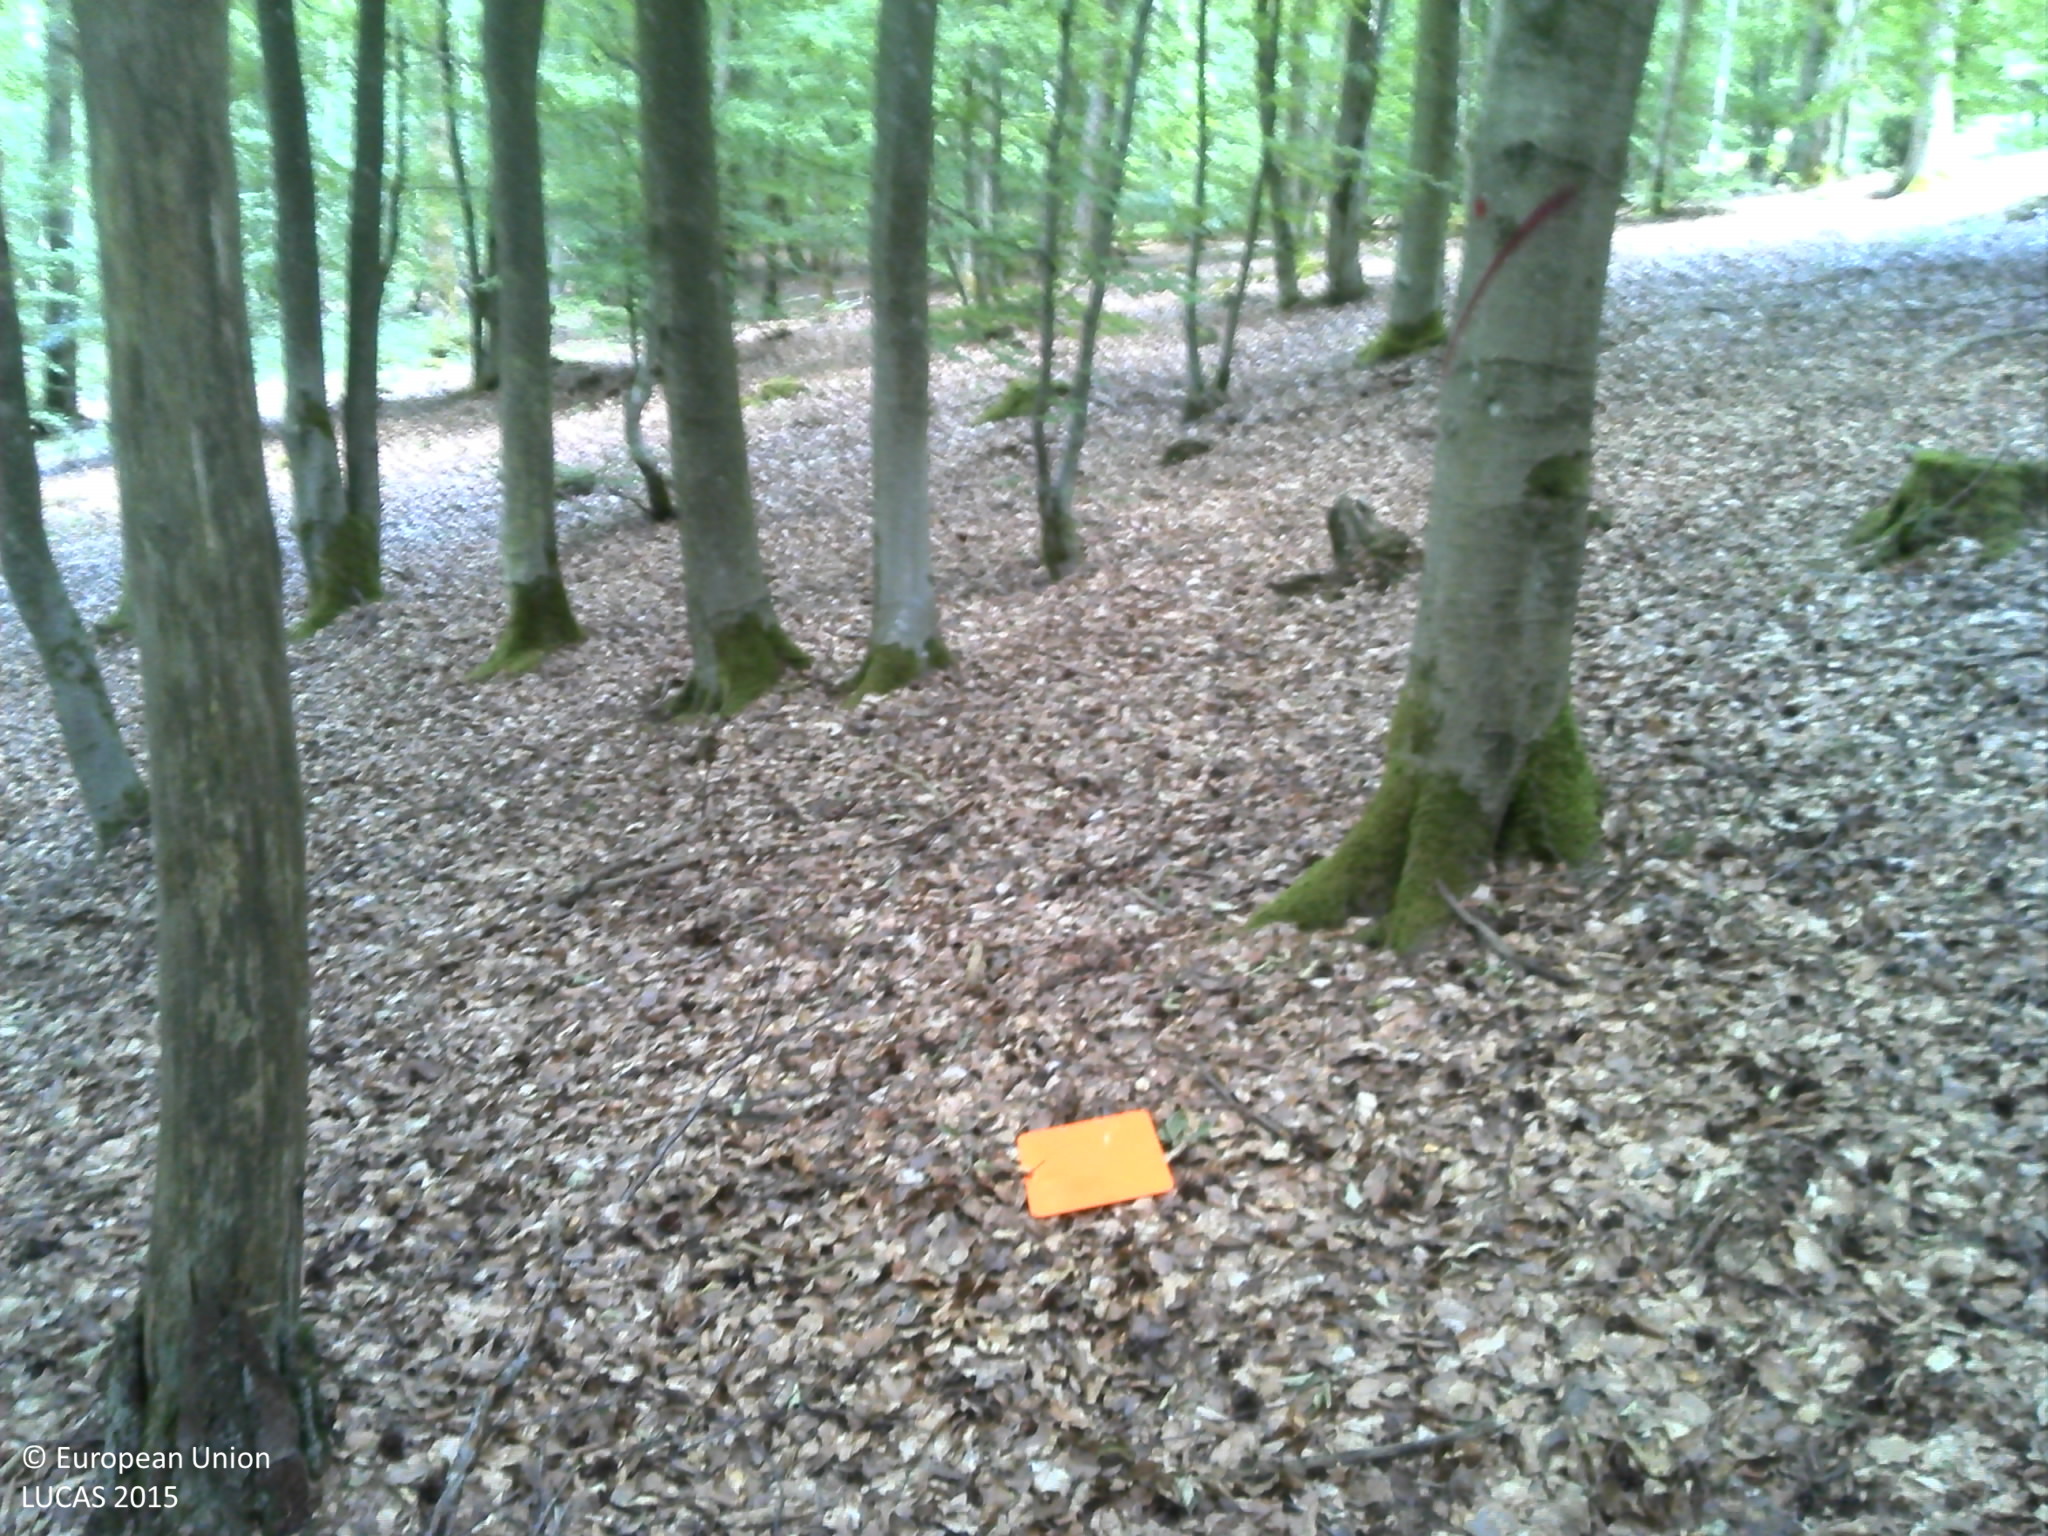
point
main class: Woodland
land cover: Broadleaved woodland
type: beech forest
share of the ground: > 75 %
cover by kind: broadleaved forest trees 95 %, coniferous forest trees 5 %
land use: Forestry
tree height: > 5 m
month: July
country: FR
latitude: 49.0957
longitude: 7.5217
